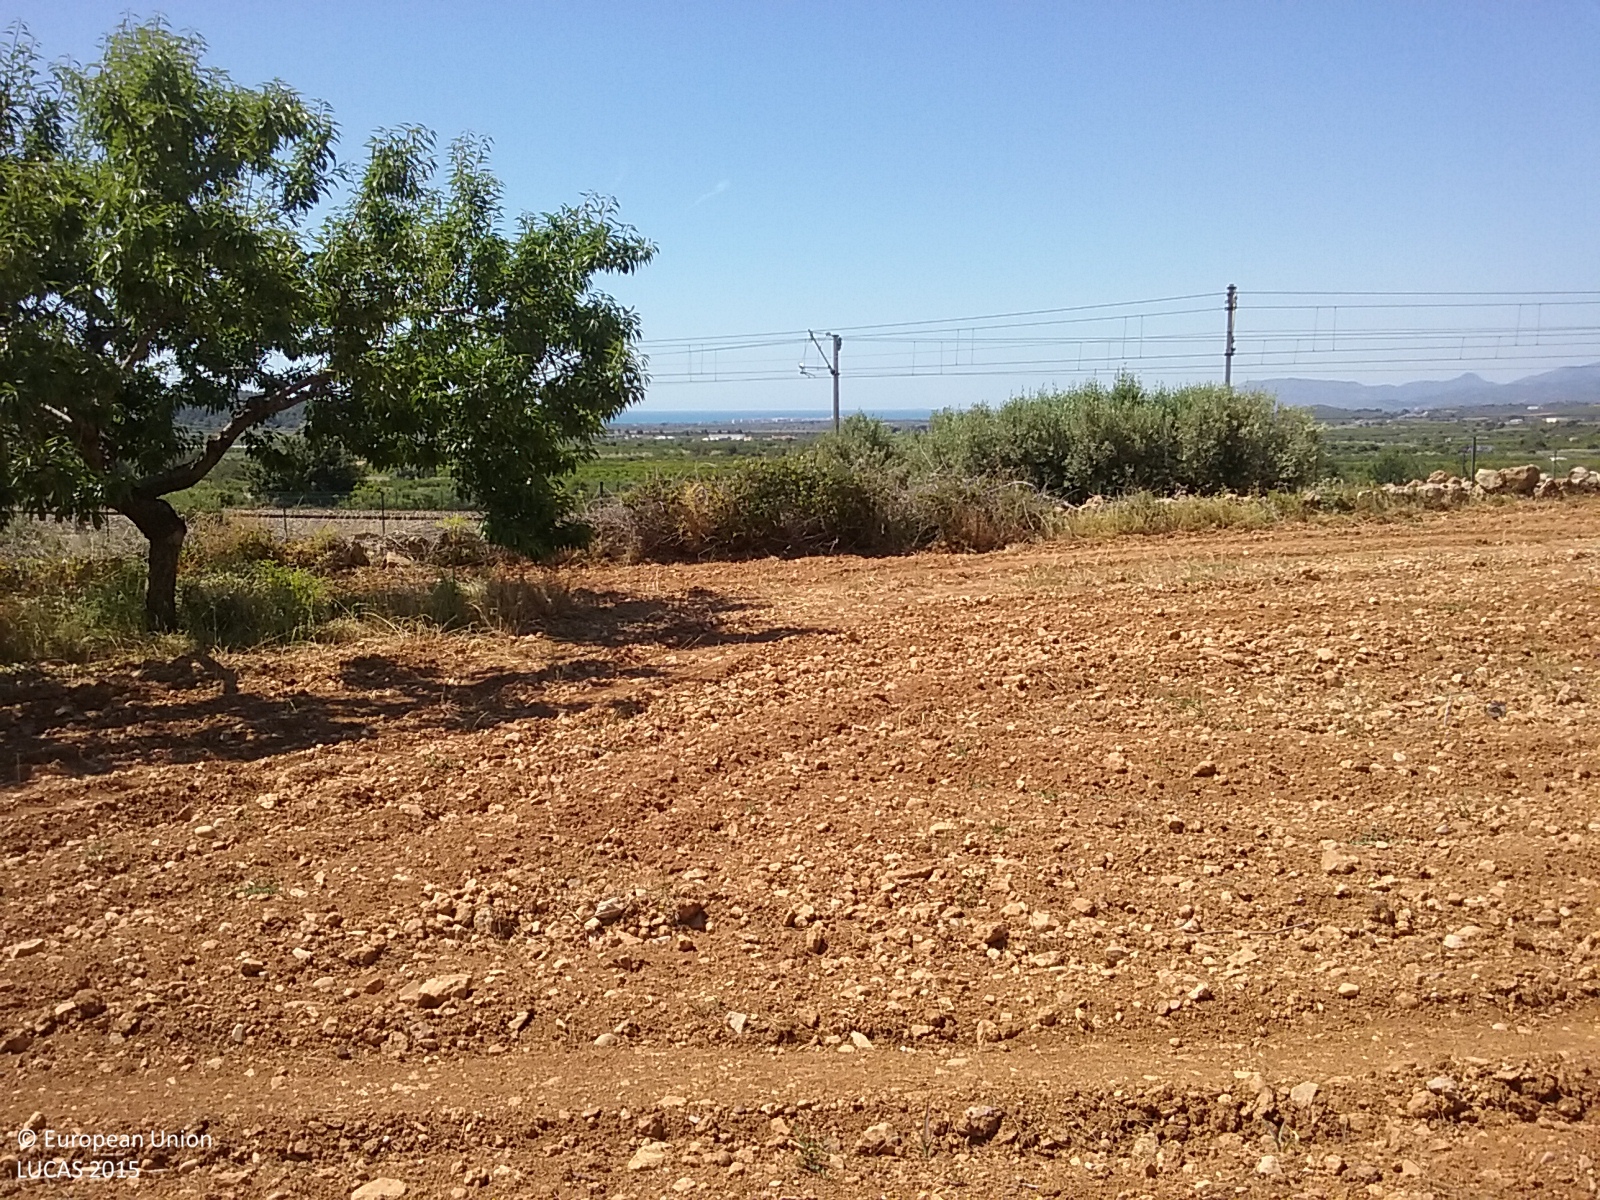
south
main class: Cropland
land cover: Nuts trees
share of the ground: < 10 %
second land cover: Other bare soil
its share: > 75 %
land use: Agriculture (excluding fallow land and kitchen gardens)
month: May
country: ES
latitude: 40.2721
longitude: 0.2484
